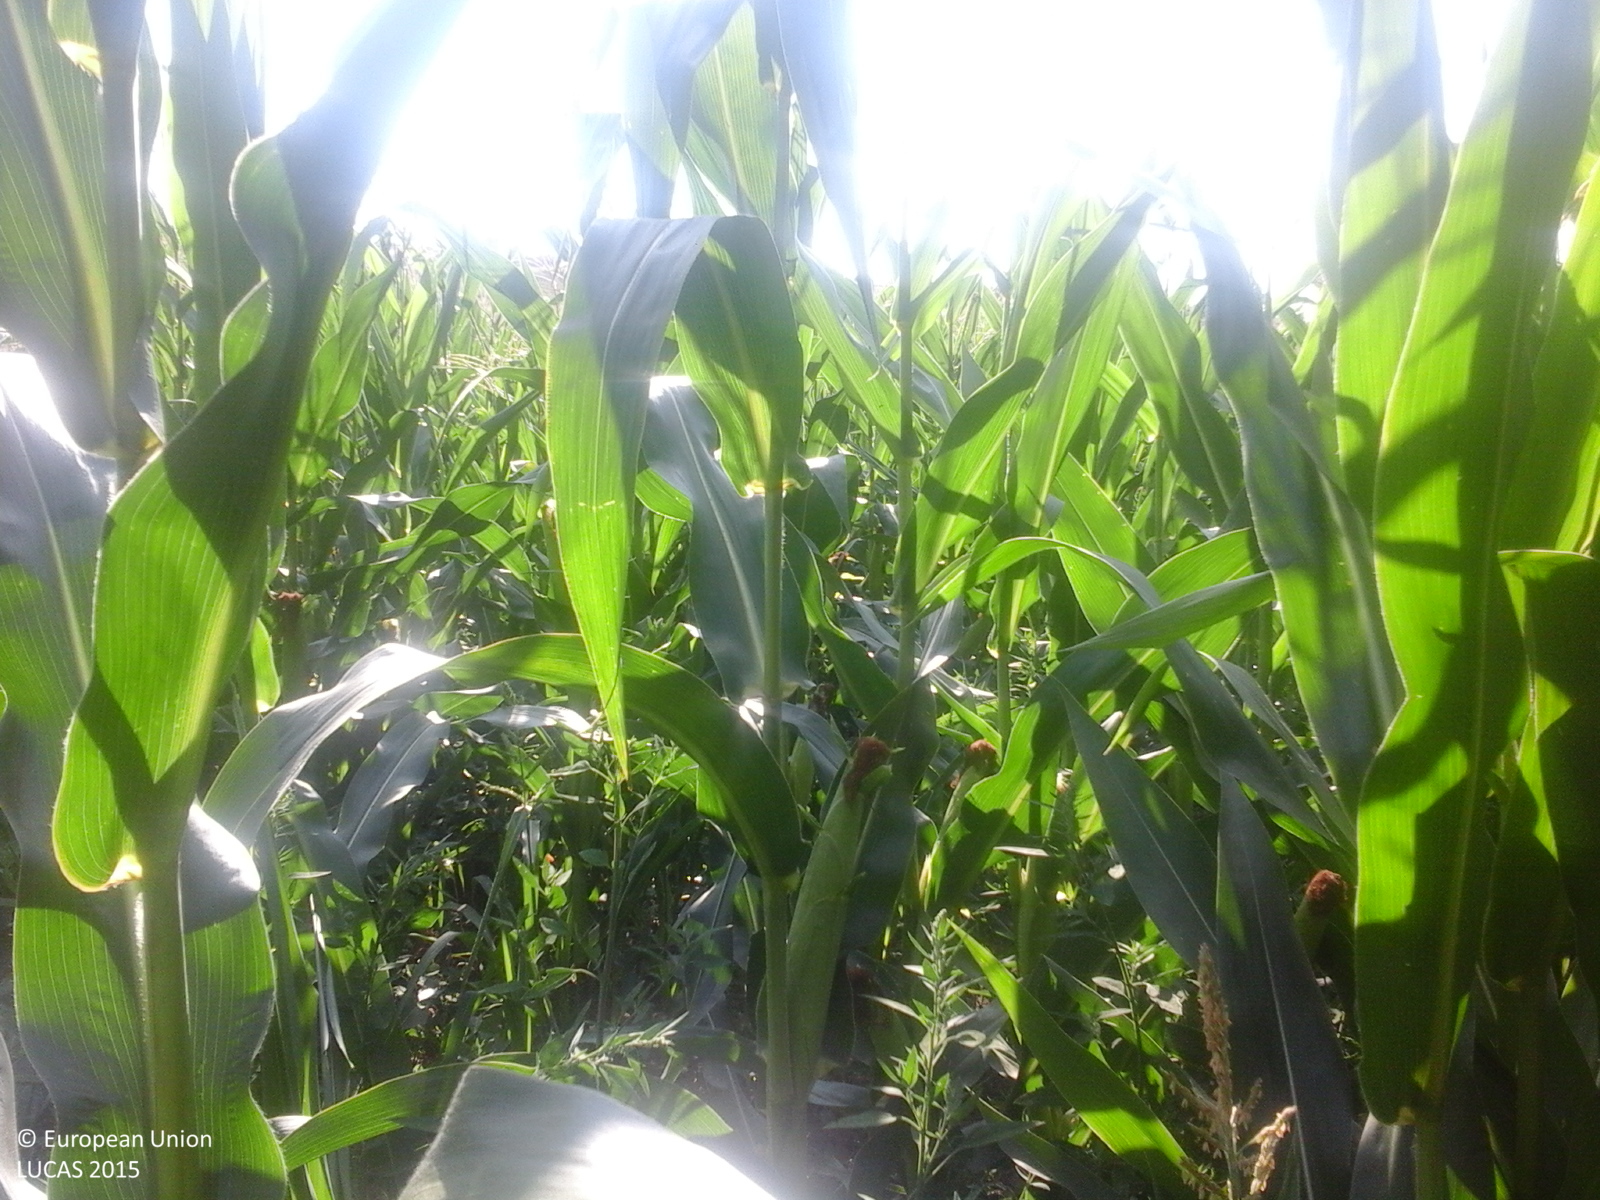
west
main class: Cropland
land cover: Maize
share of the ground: > 75 %
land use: Agriculture (excluding fallow land and kitchen gardens)
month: July
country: RO
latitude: 46.4356
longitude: 27.9683
